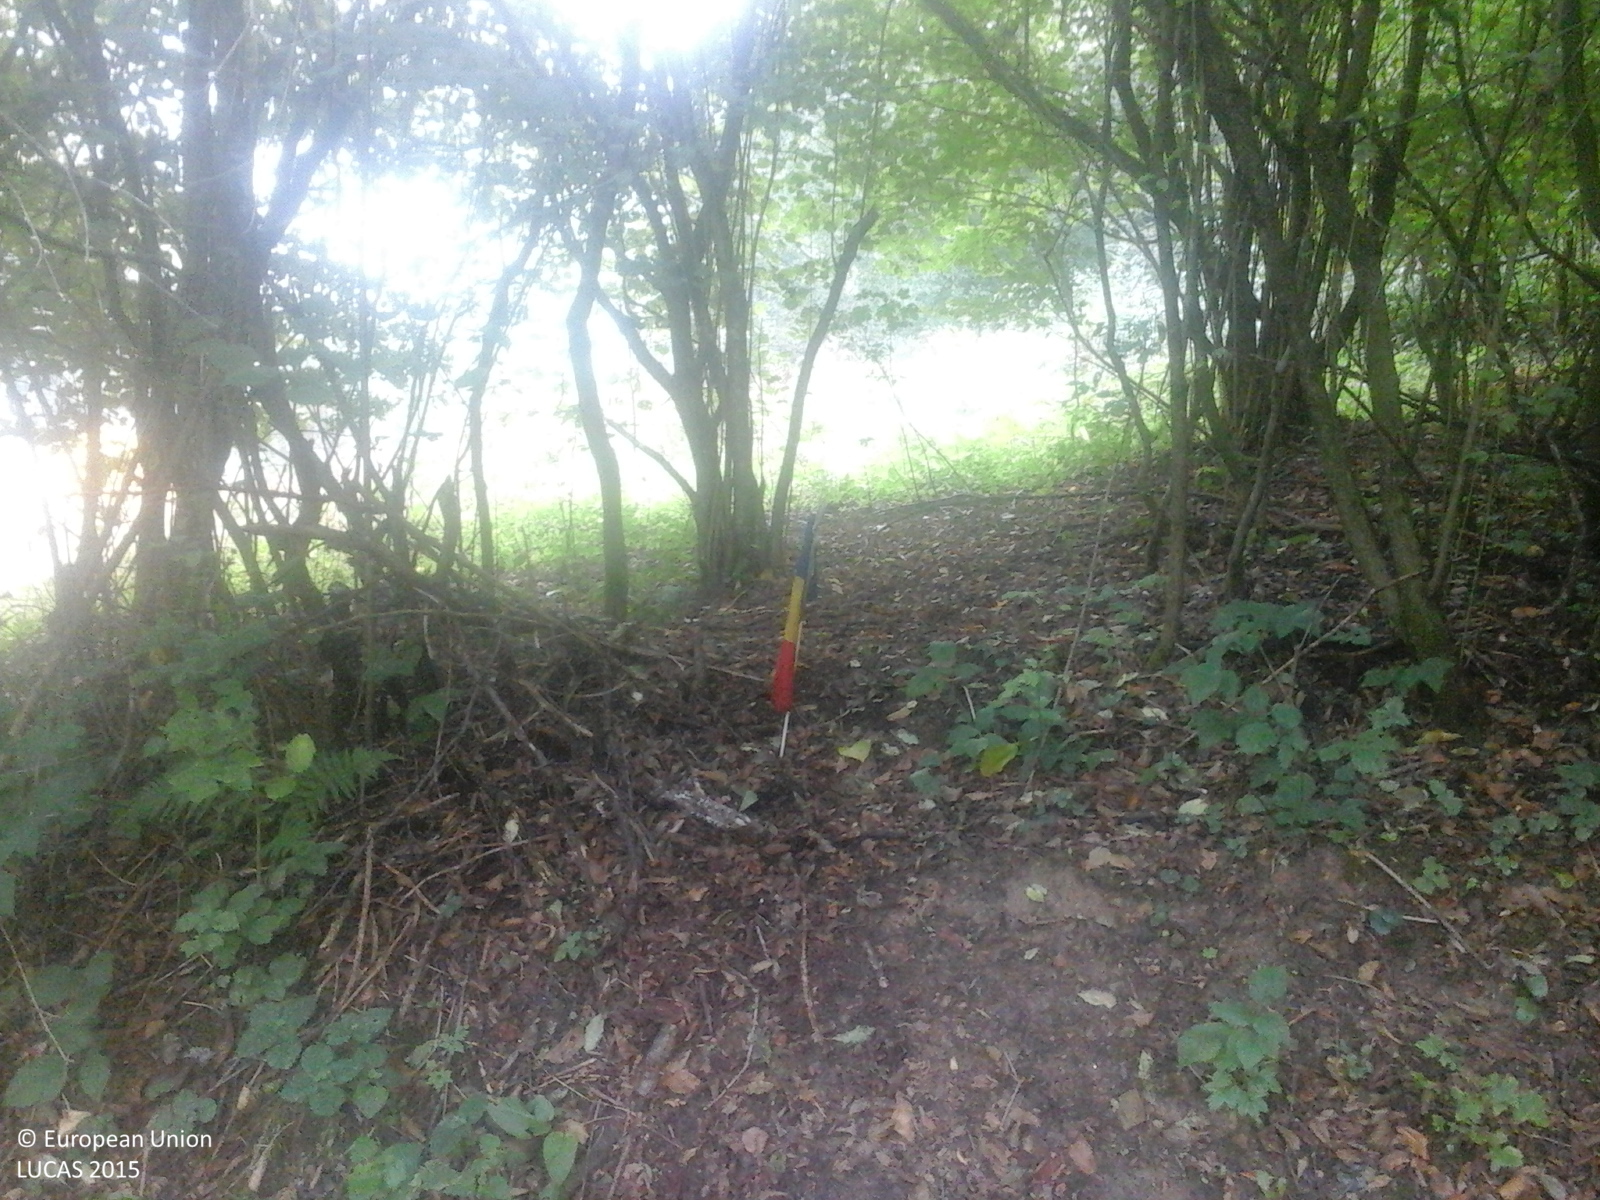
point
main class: Woodland
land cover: Broadleaved woodland
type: mesophytic deciduous forest
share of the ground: > 75 %
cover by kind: broadleaved forest trees 100 %
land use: Forestry
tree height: > 5 m
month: September
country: RO
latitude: 45.6502
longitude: 23.1055
